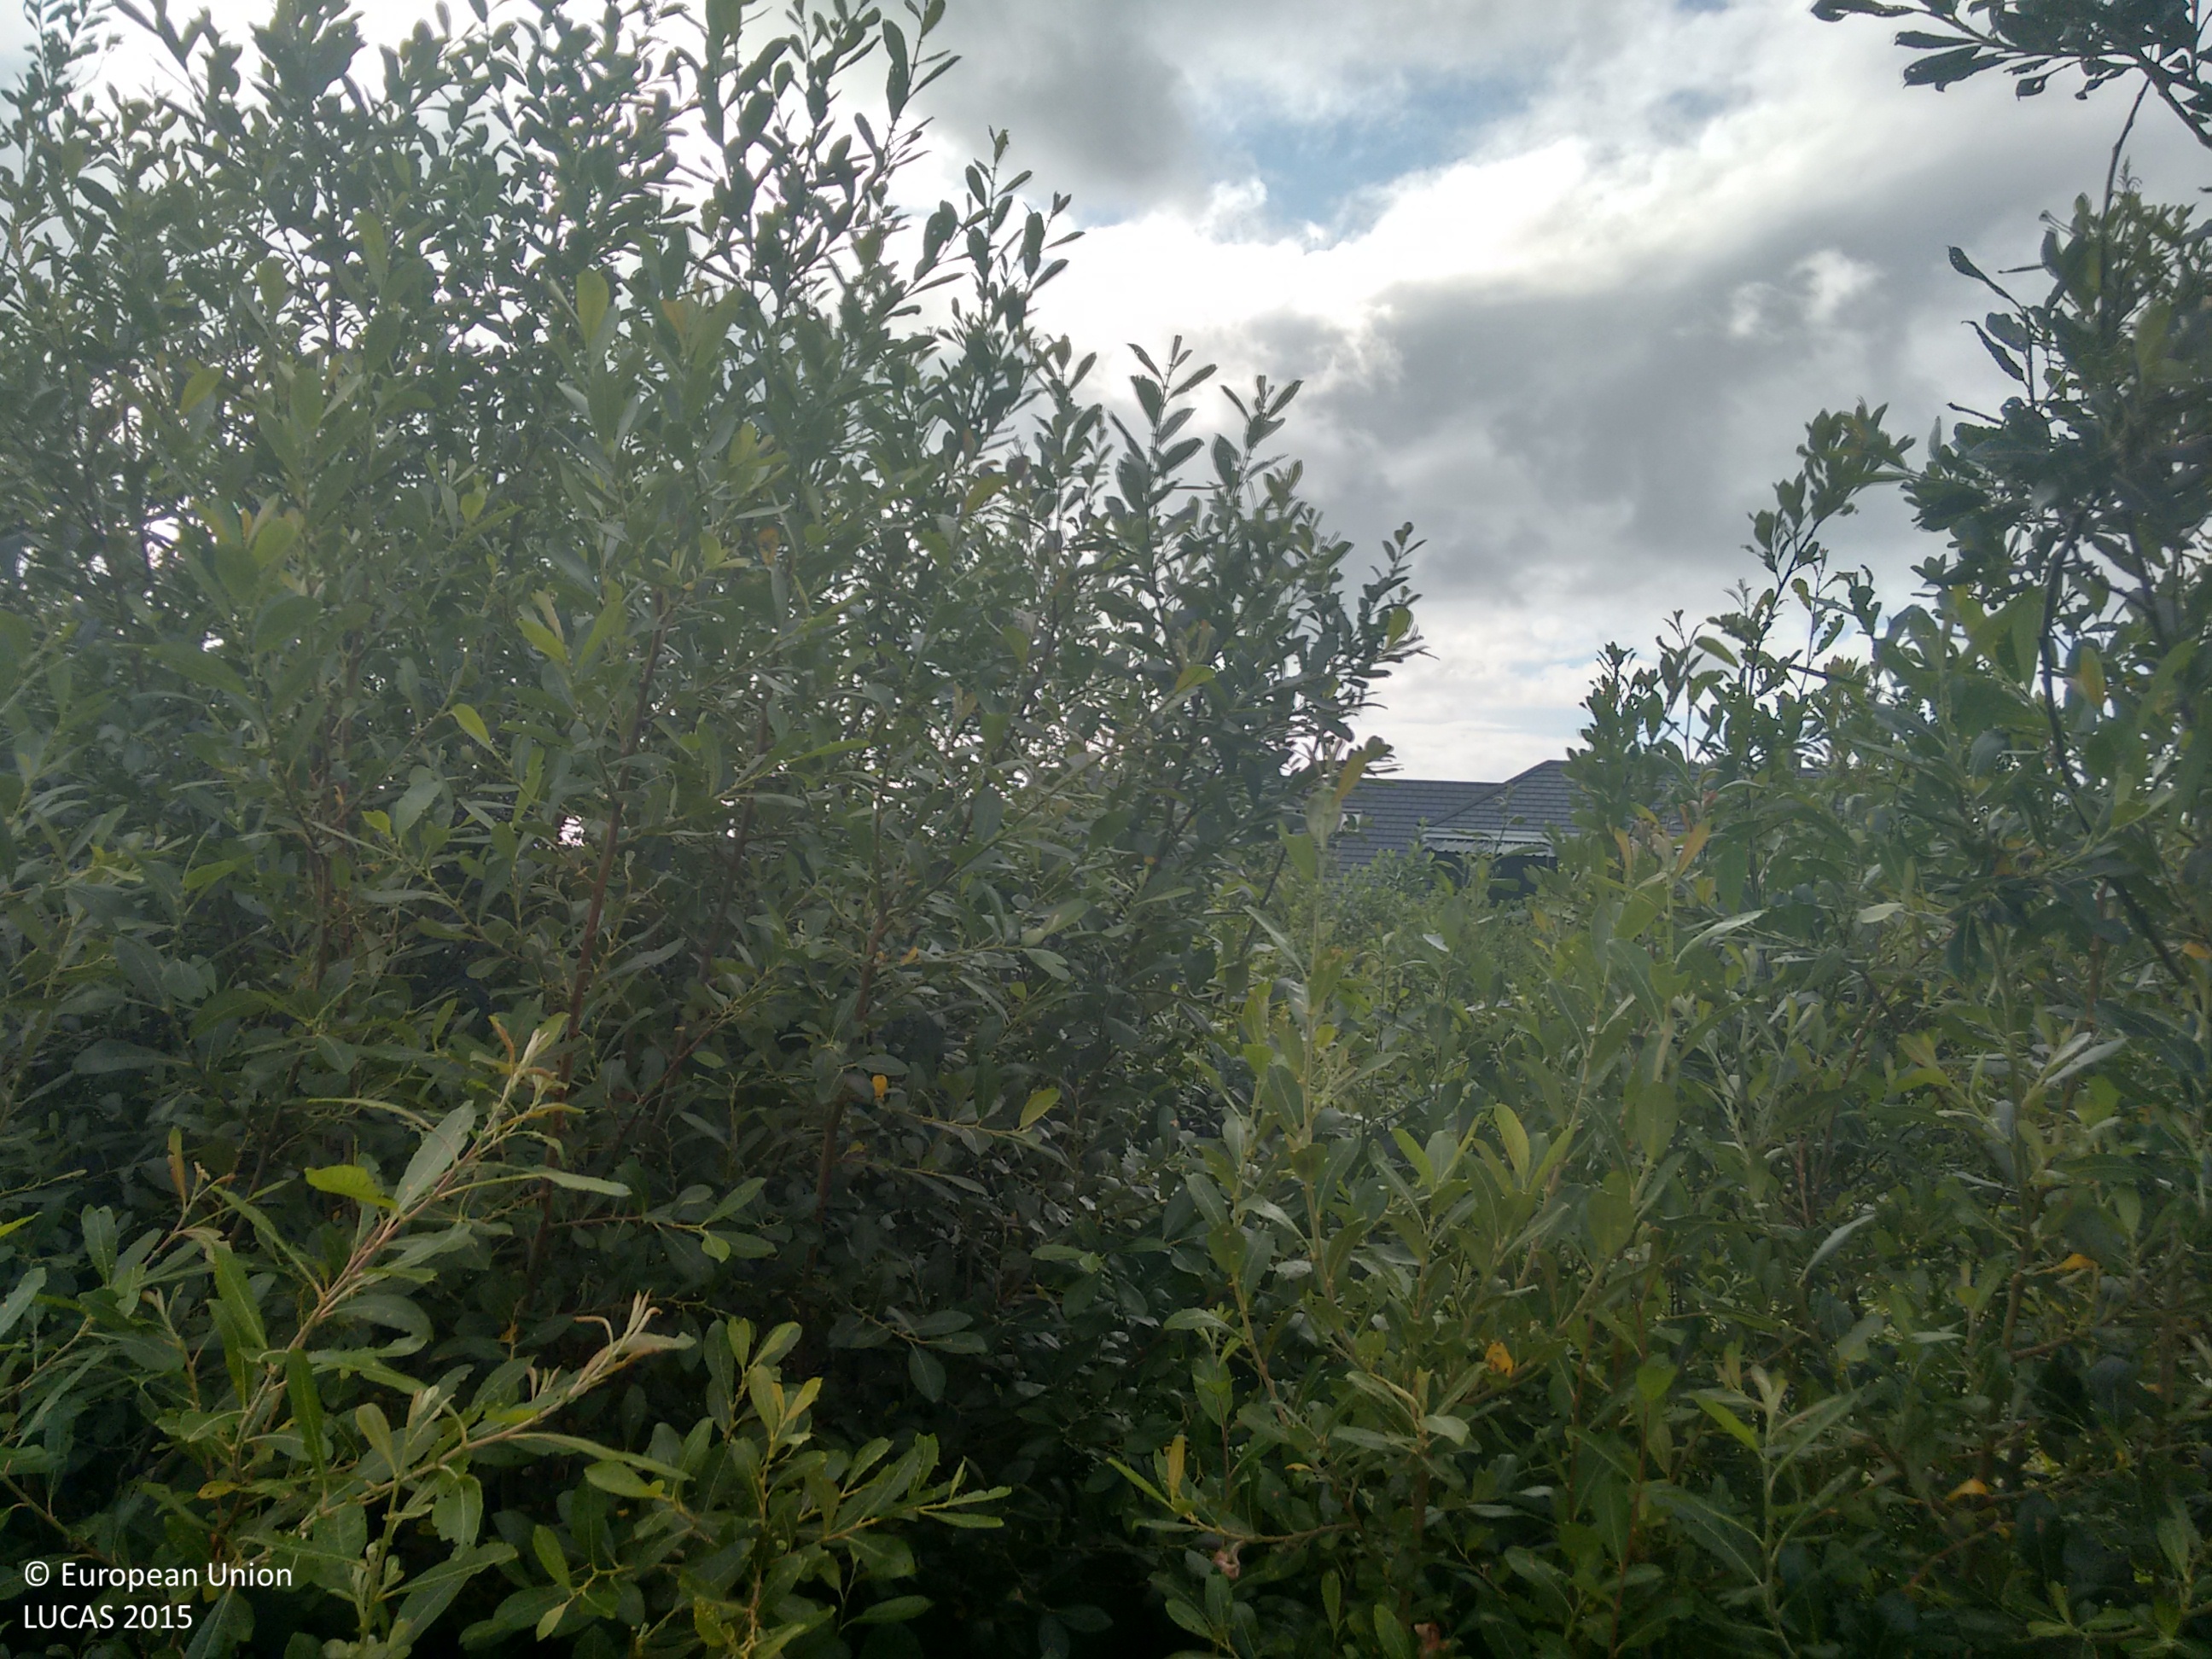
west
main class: Grassland
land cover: Grassland with sparse tree/shrub cover
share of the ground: > 75 %
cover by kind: herbaceous plants 85 %, shrubs 10 %, broadleaved forest trees 5 %
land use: Semi-natural and natural areas not in use
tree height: < 5 m
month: July
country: IE
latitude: 53.5539
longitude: -9.9500
